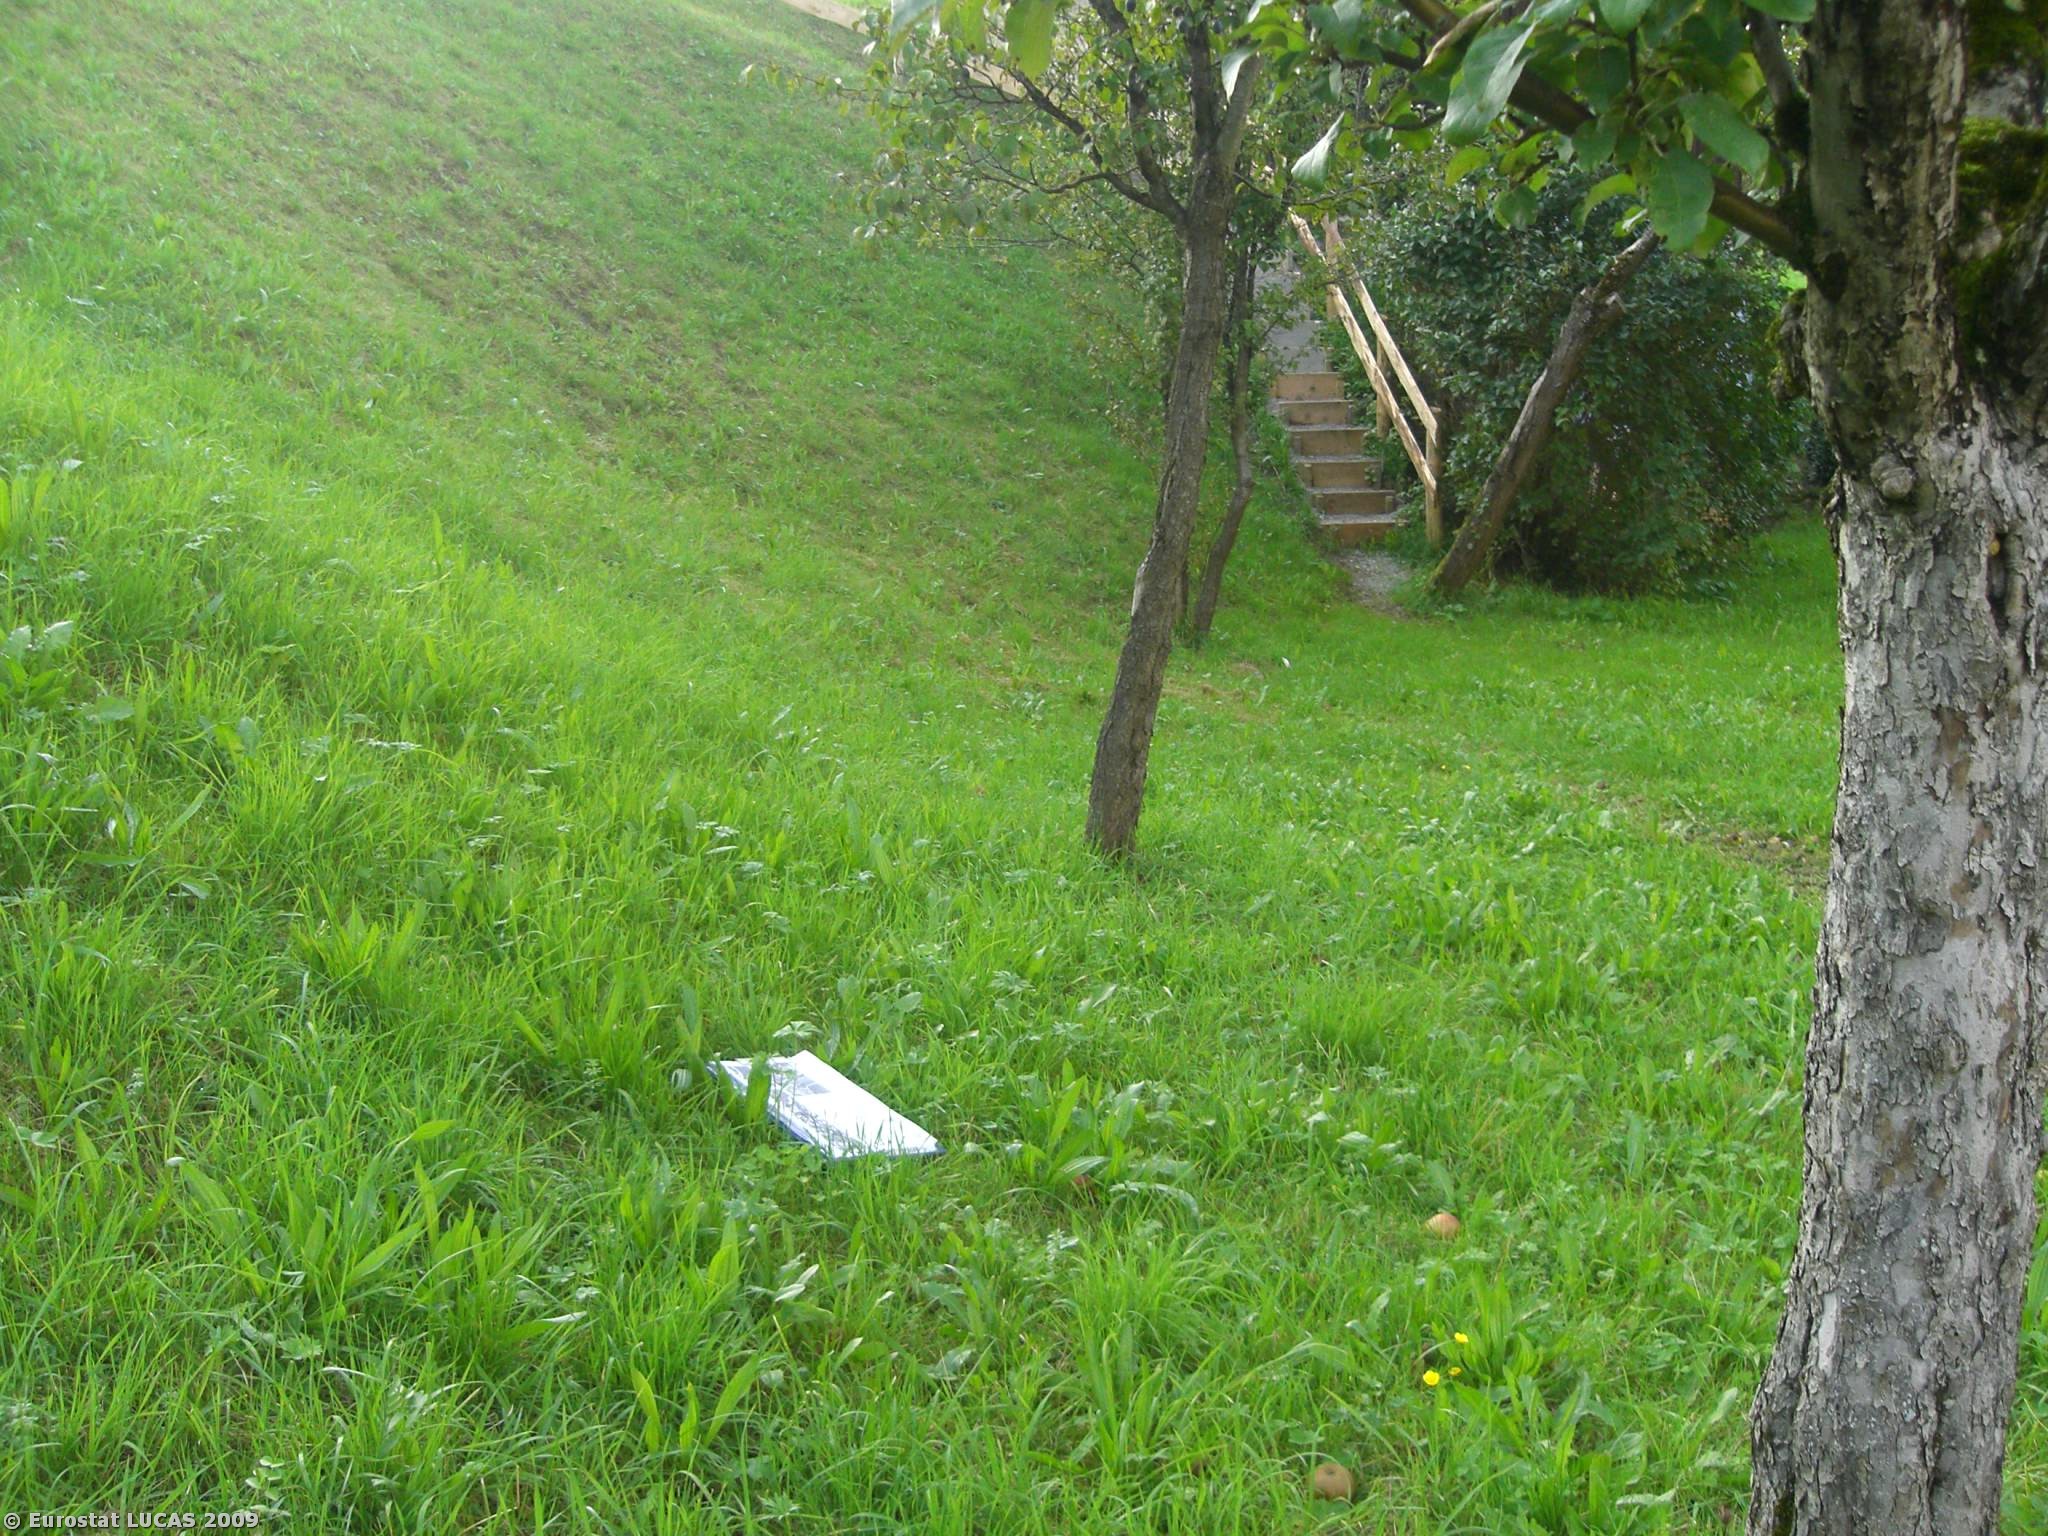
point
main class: Grassland
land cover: Grassland with sparse tree/shrub cover
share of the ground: > 75 %
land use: Agriculture (excluding fallow land and kitchen gardens)
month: May
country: AT
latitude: 47.9423
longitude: 13.2253
